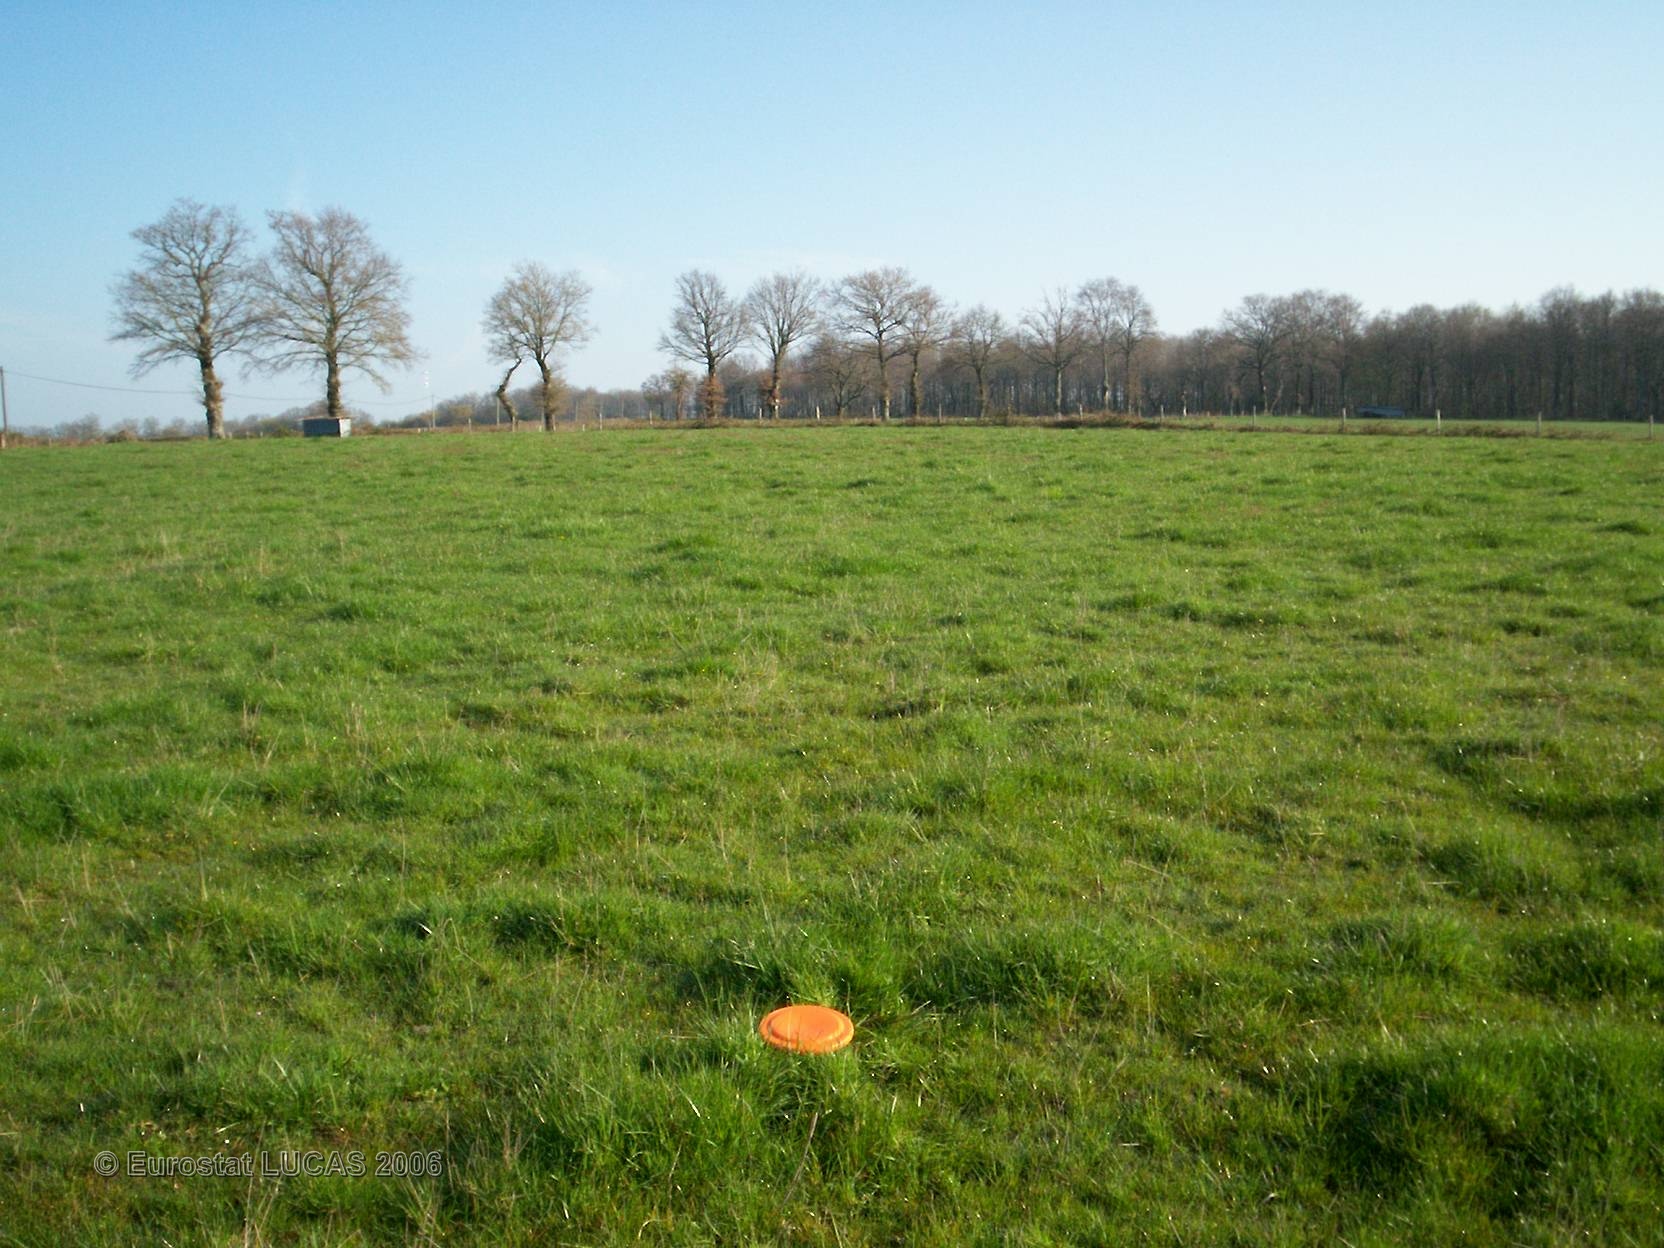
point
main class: Grassland
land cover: Grassland without tree/shrub cover
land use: Agriculture (excluding fallow land and kitchen gardens)
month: April
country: FR
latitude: 46.2694
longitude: 1.0997
